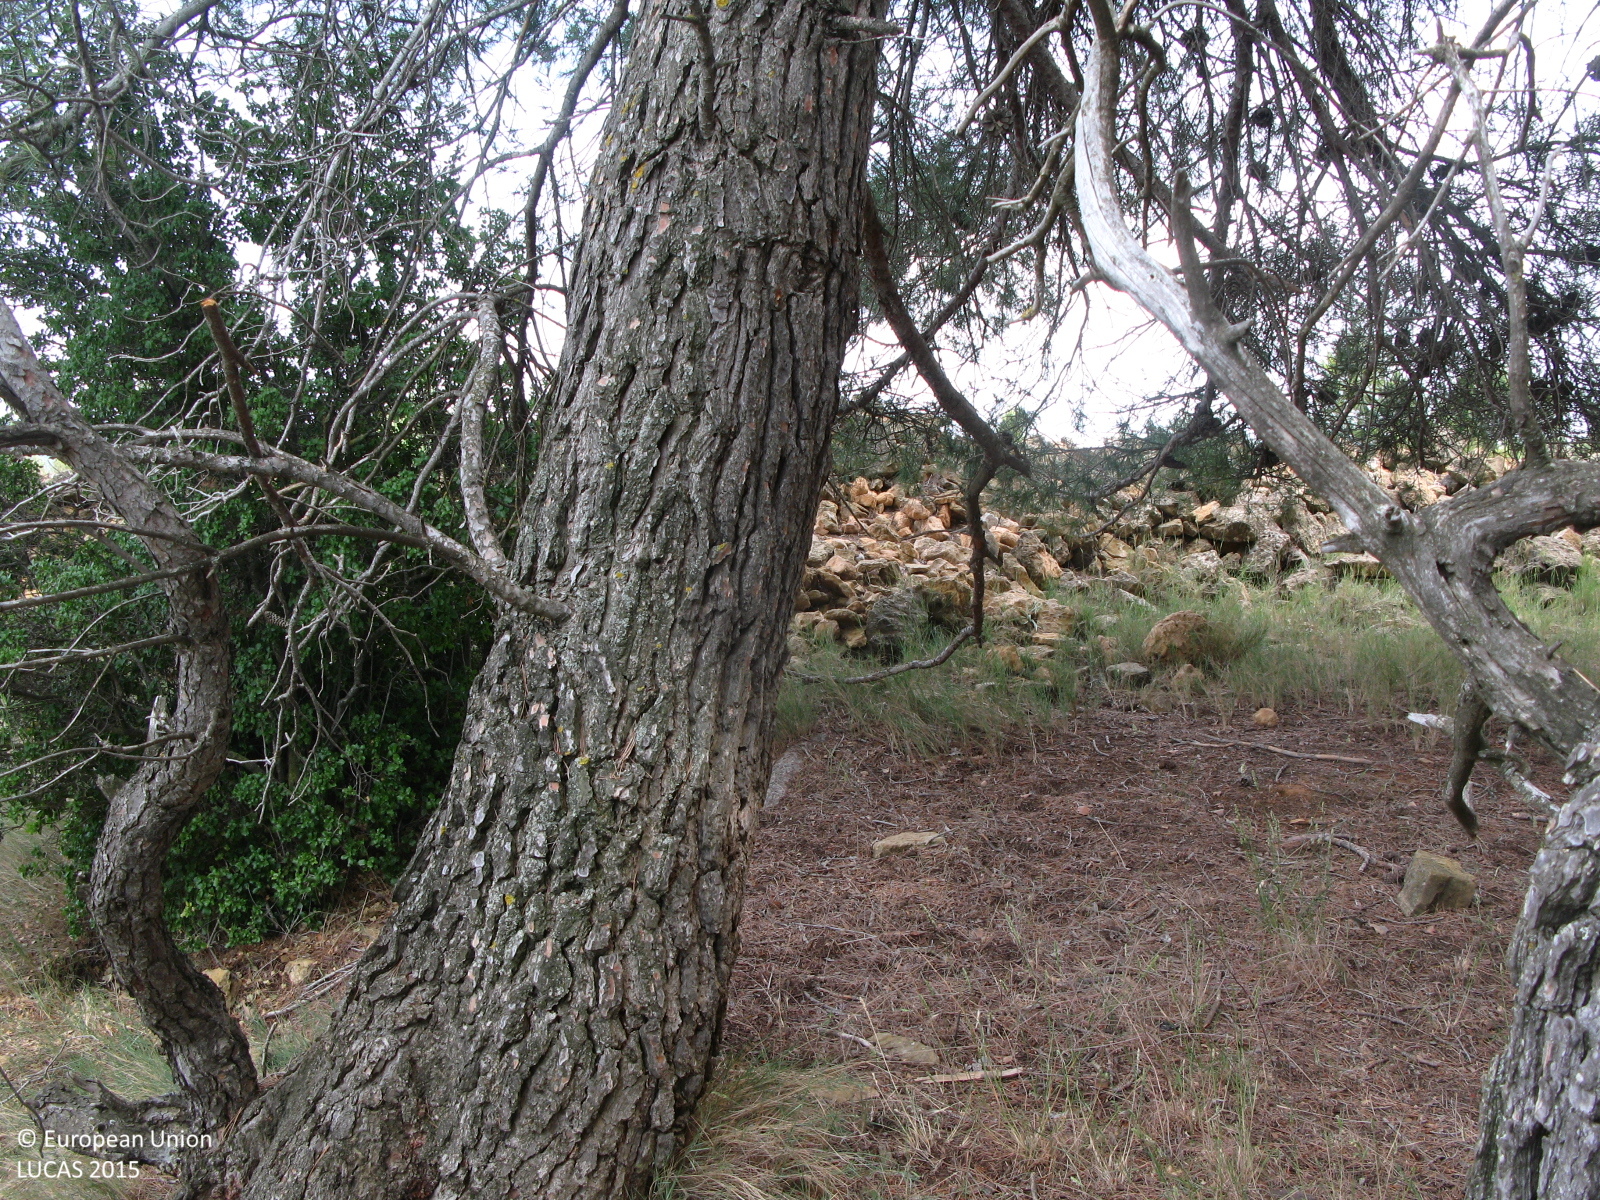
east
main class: Woodland
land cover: Pine dominated coniferous woodland
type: coniferous forest of the mediterranean region
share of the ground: 25 - 50 %
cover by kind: shrubs 40 %, herbaceous plants 30 %, coniferous forest trees 25 %, broadleaved forest trees 5 %
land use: Forestry
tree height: > 5 m
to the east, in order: Pine dominated coniferous woodland; Dry stone walls; Shrubland without tree cover; Paved roads, cycling and walking lanes; Shrubland with sparse tree cover; Spontaneously vegetated surfaces; Nuts trees; Shrubland without tree cover; Dry stone walls; Grassland without tree/shrub cover; Shrubland without tree cover; Dry stone walls; Spontaneously vegetated surfaces
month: June
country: ES
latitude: 39.8320
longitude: -0.9762
